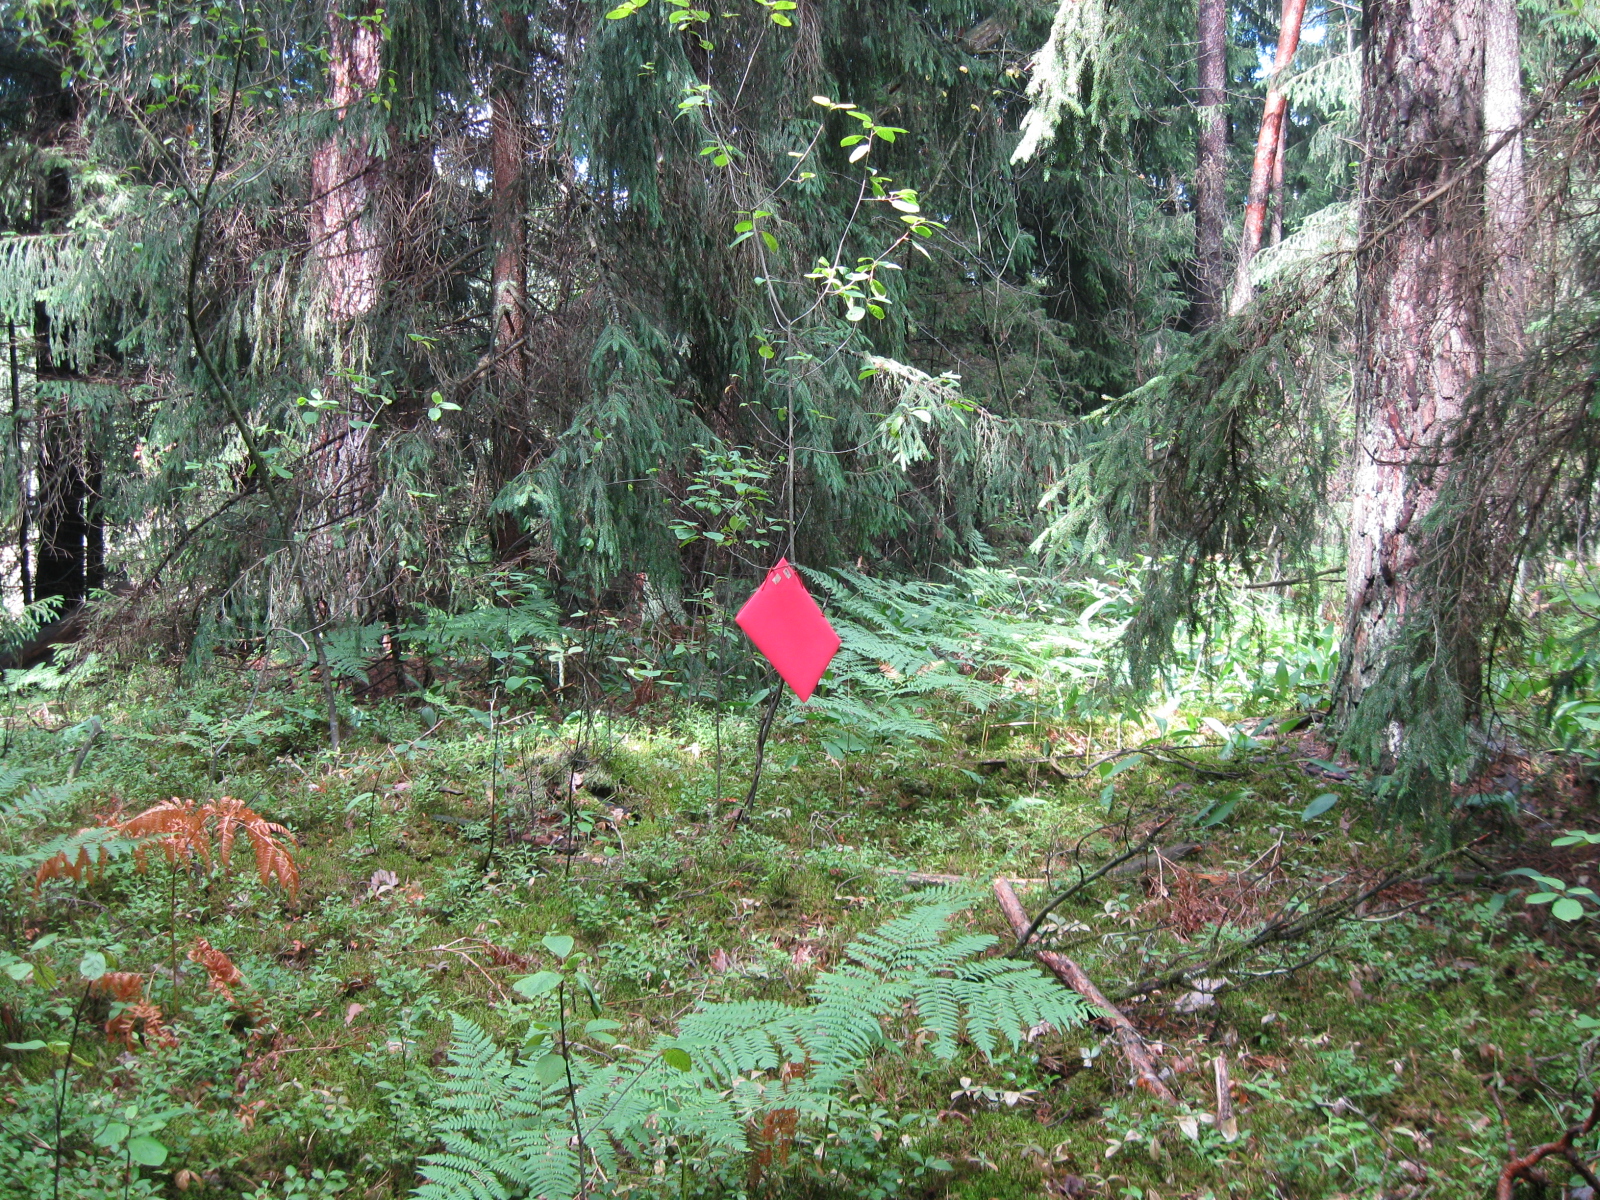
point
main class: Woodland
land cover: Other coniferous woodland
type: hemiboreal forest and nemoral coniferous forest and mixed broadleaved-coniferous forest
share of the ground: > 75 %
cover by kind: coniferous forest trees 80 %, lichens and mosses 10 %, broadleaved forest trees 5 %, herbaceous plants 5 %
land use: Forestry
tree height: > 5 m
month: July
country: LT
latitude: 53.9582
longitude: 23.6343
